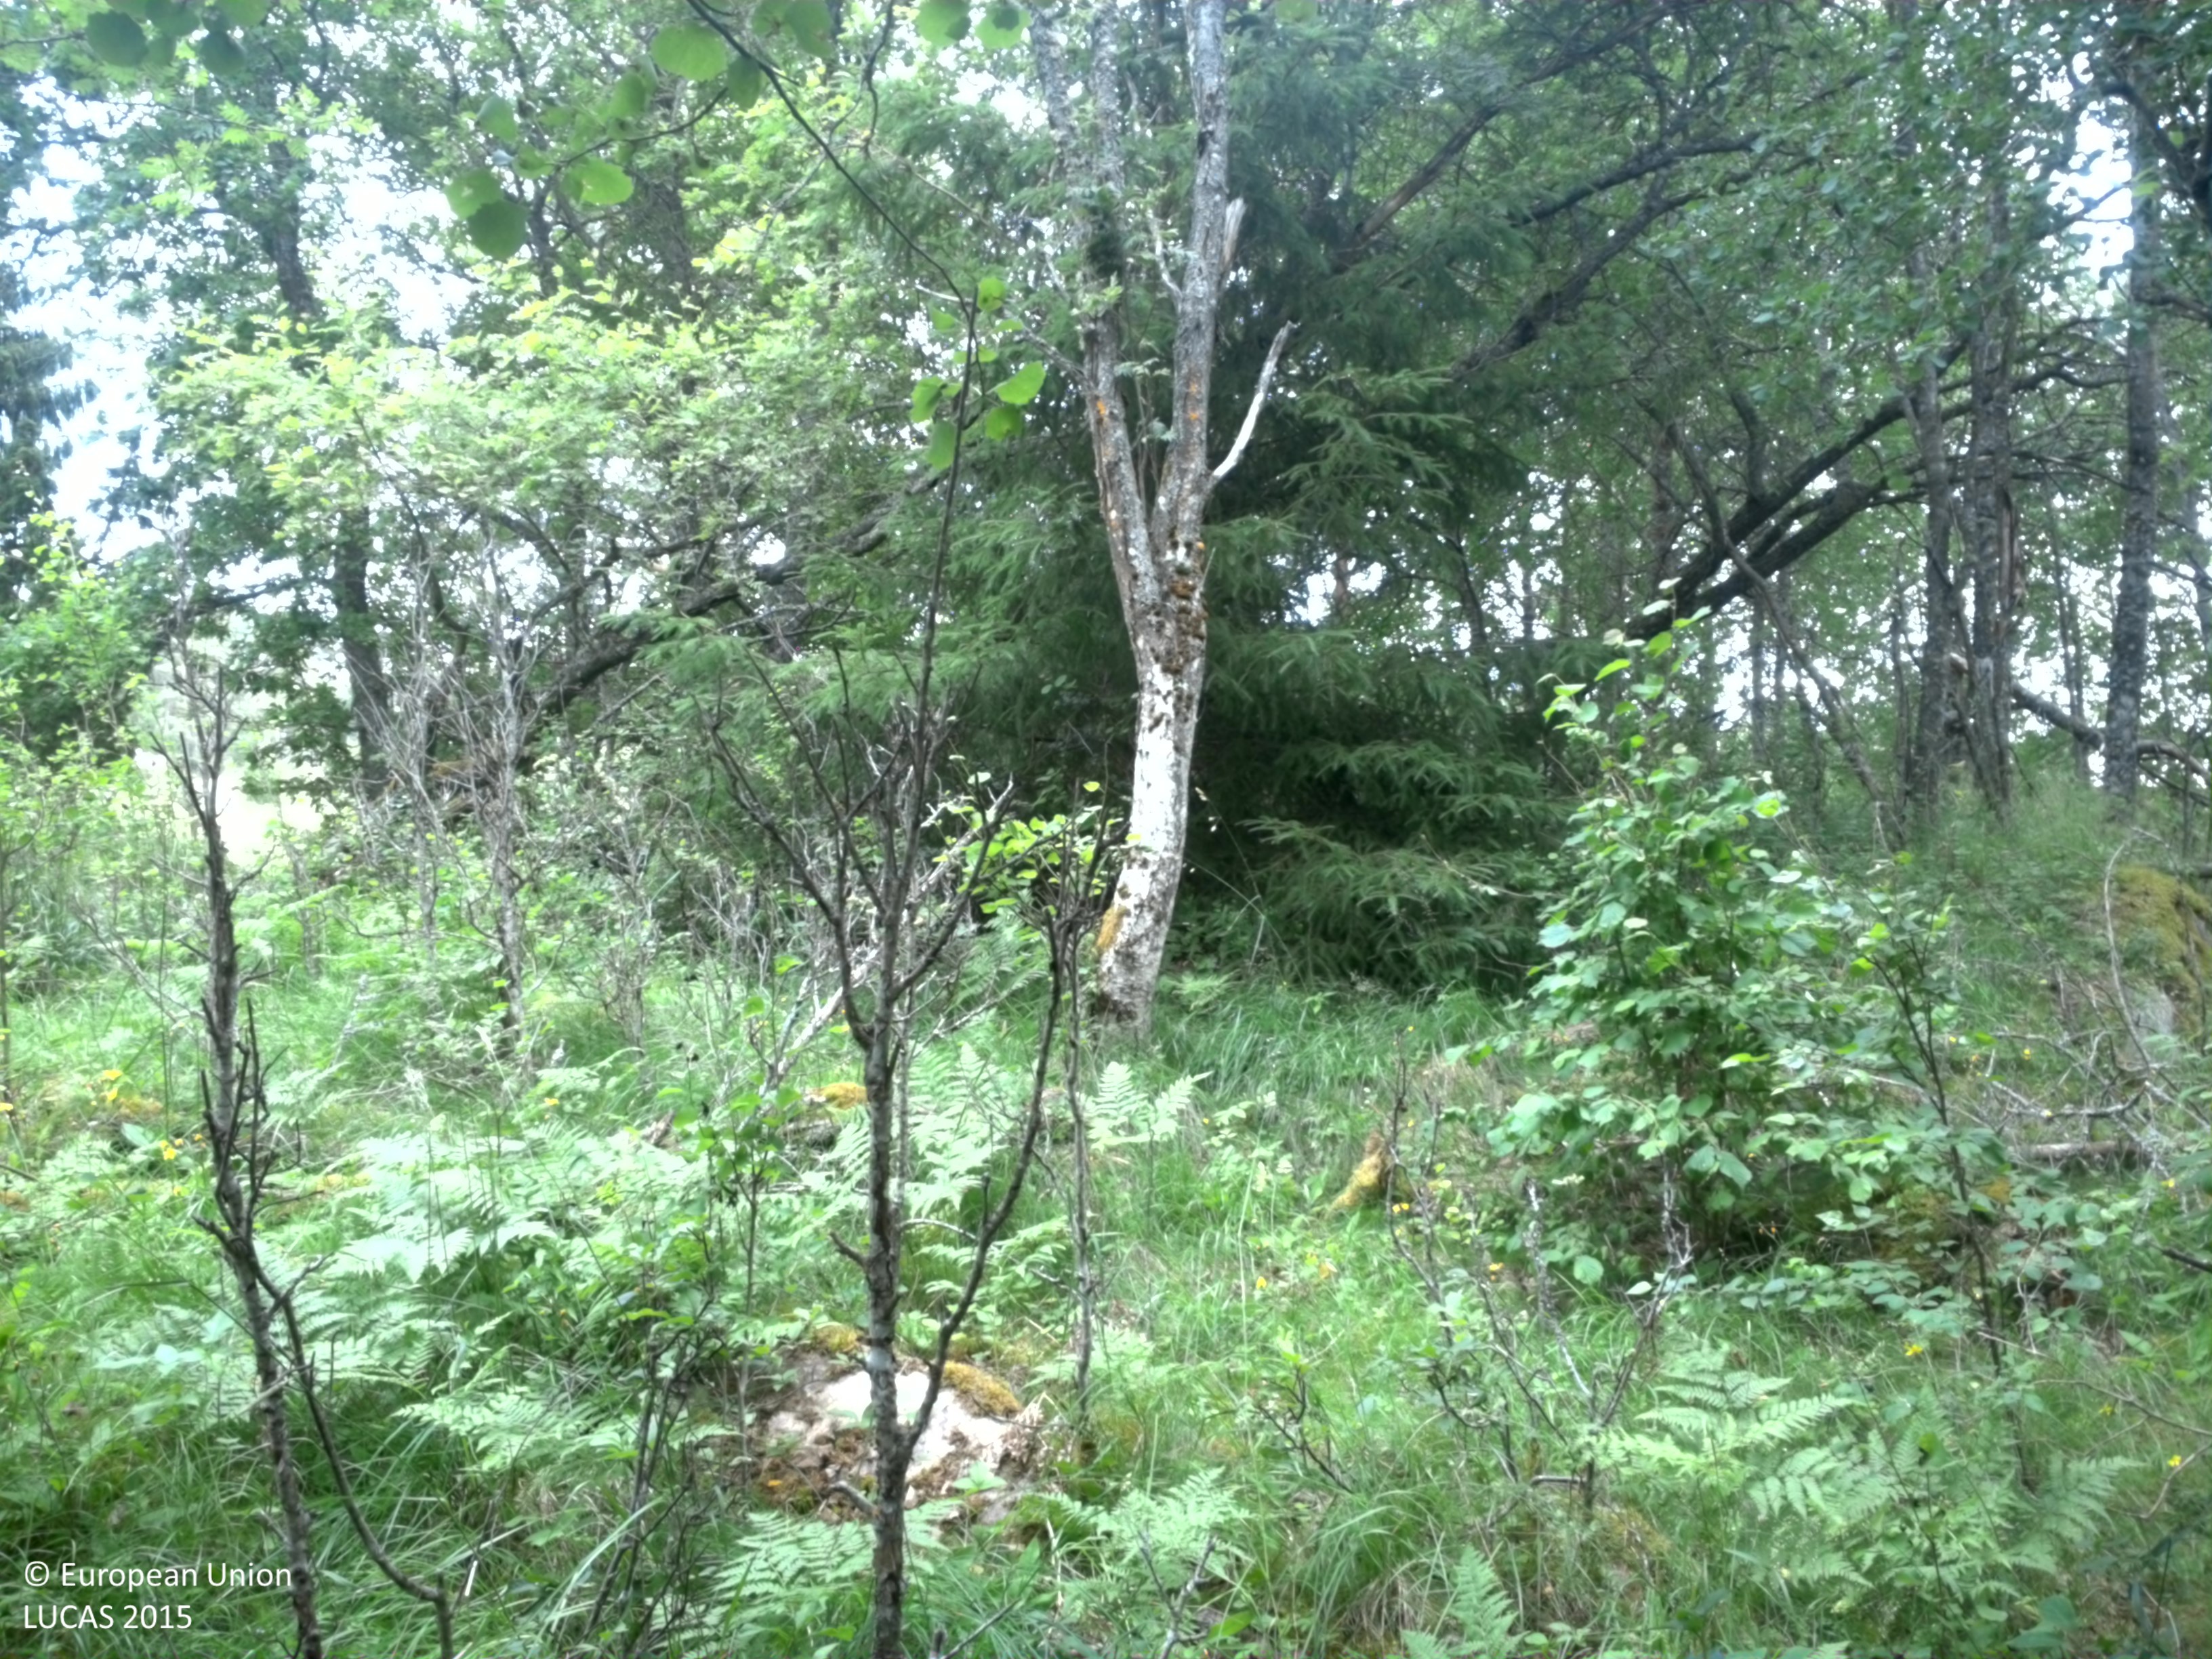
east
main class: Woodland
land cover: Broadleaved woodland
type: boreal forest
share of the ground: > 75 %
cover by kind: broadleaved forest trees 65 %, coniferous forest trees 20 %, herbaceous plants 15 %
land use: Forestry
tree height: > 5 m
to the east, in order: Broadleaved woodland; Grassland with sparse tree/shrub cover; Tracks; Rye; Grassland with sparse tree/shrub cover; Paved roads, cycling and walking lanes; Pine dominated coniferous woodland; Pine dominated mixed woodland
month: July
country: SE
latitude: 59.7645
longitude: 17.4896
